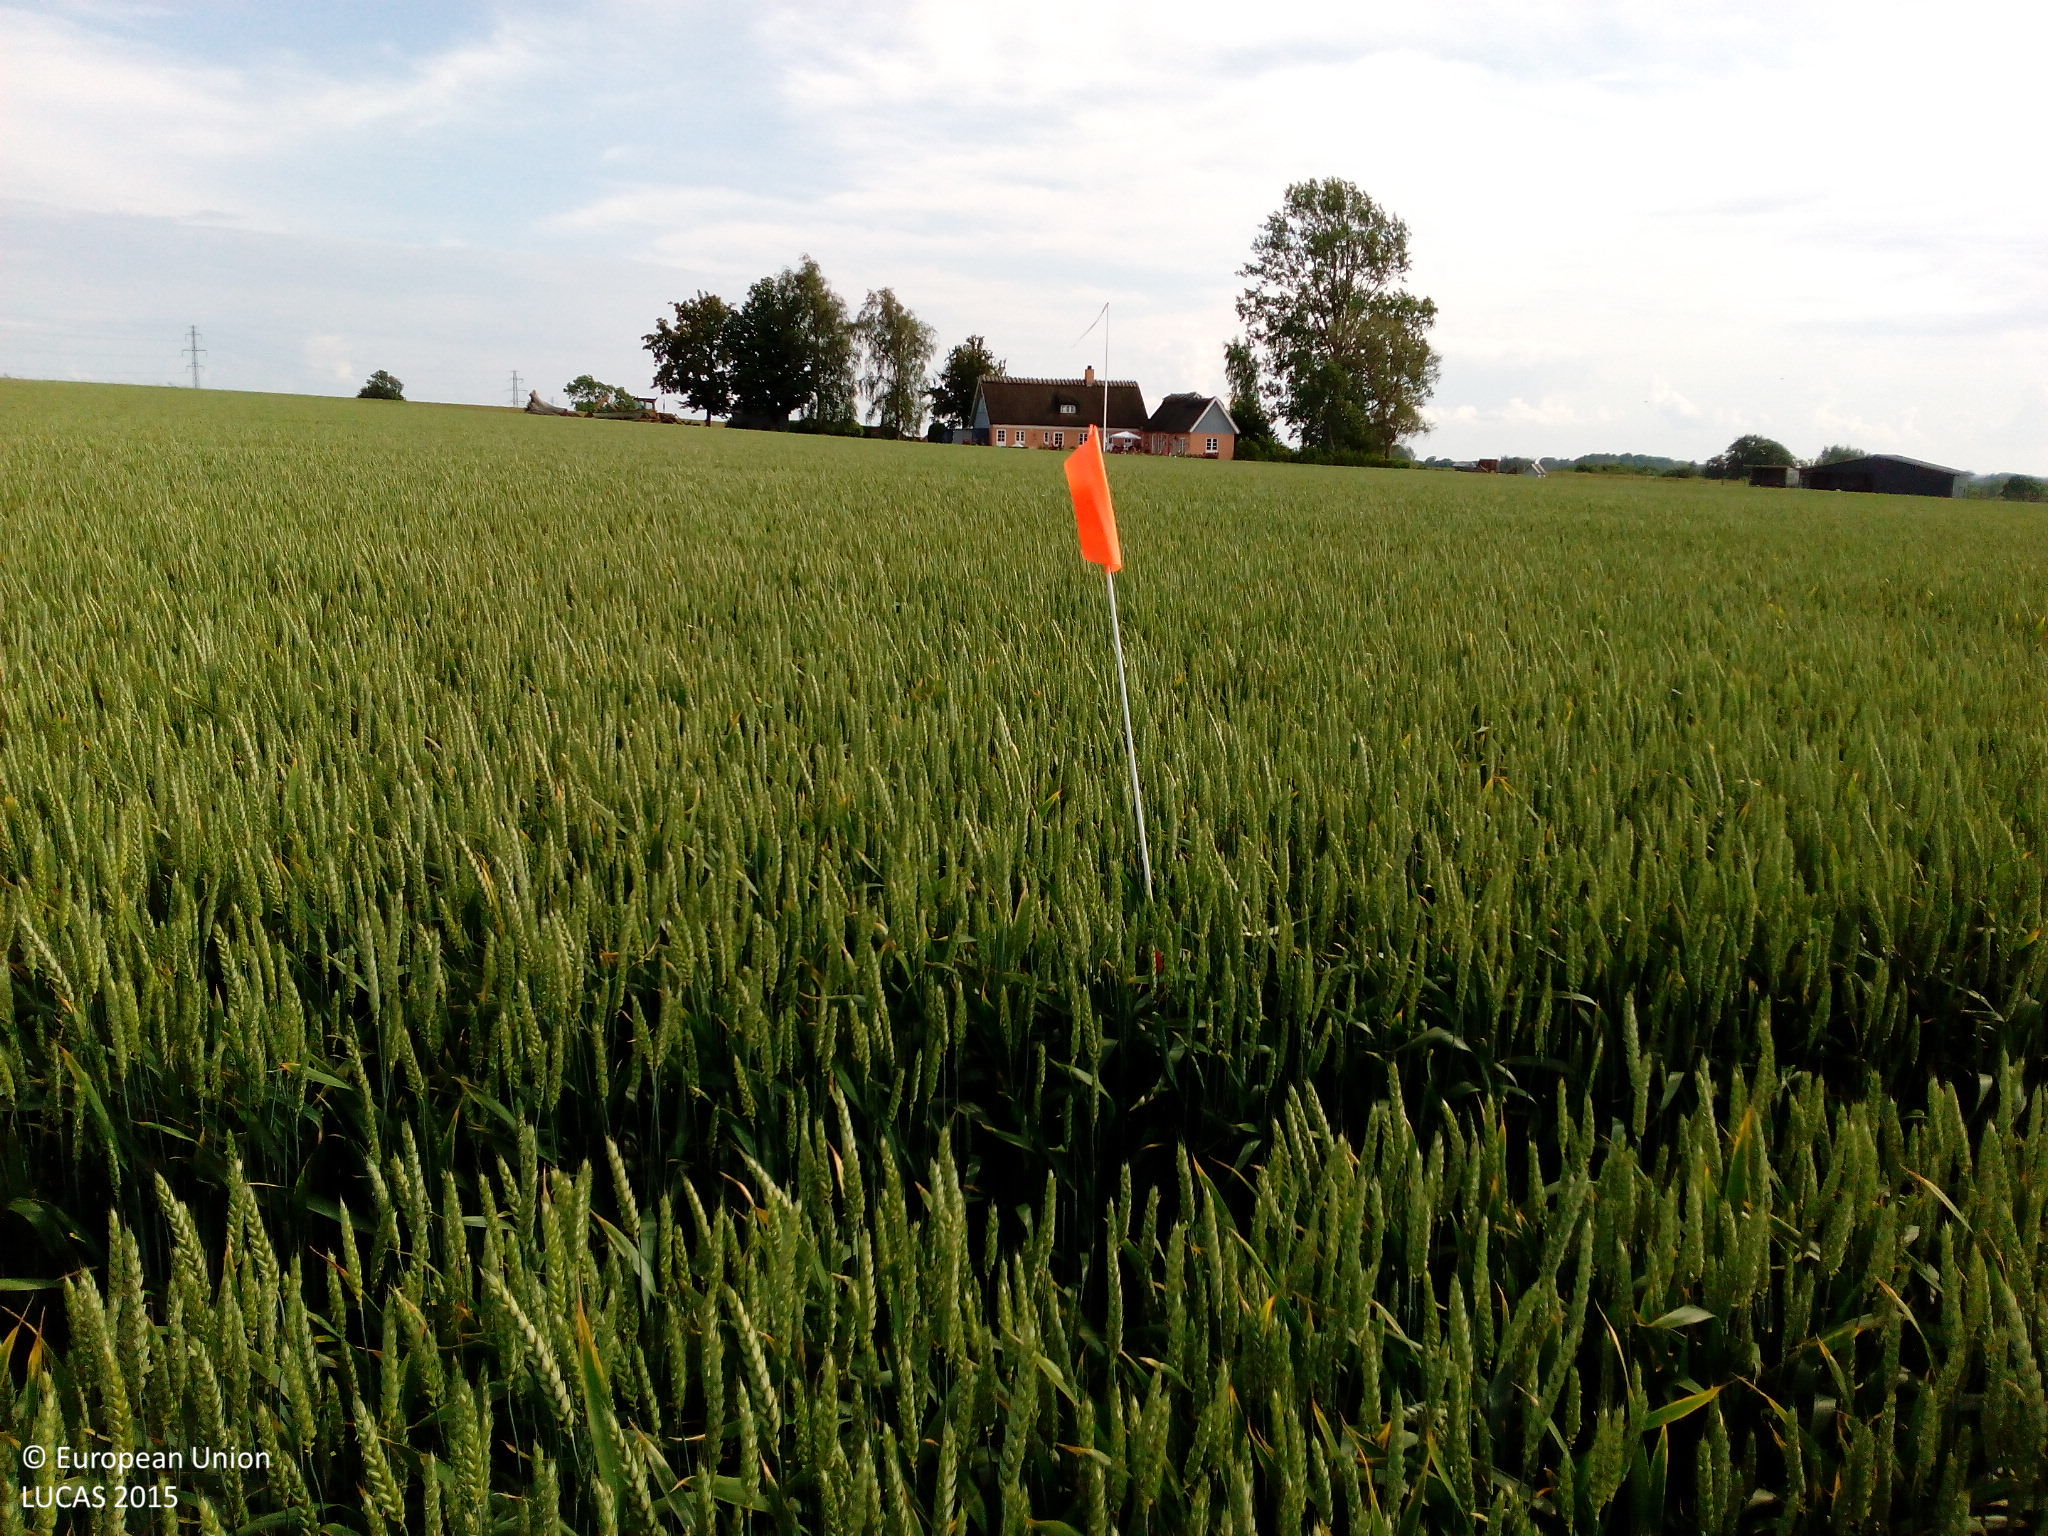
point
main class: Cropland
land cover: Common wheat
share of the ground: > 75 %
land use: Agriculture (excluding fallow land and kitchen gardens)
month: June
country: DK
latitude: 55.0950
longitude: 11.8947
